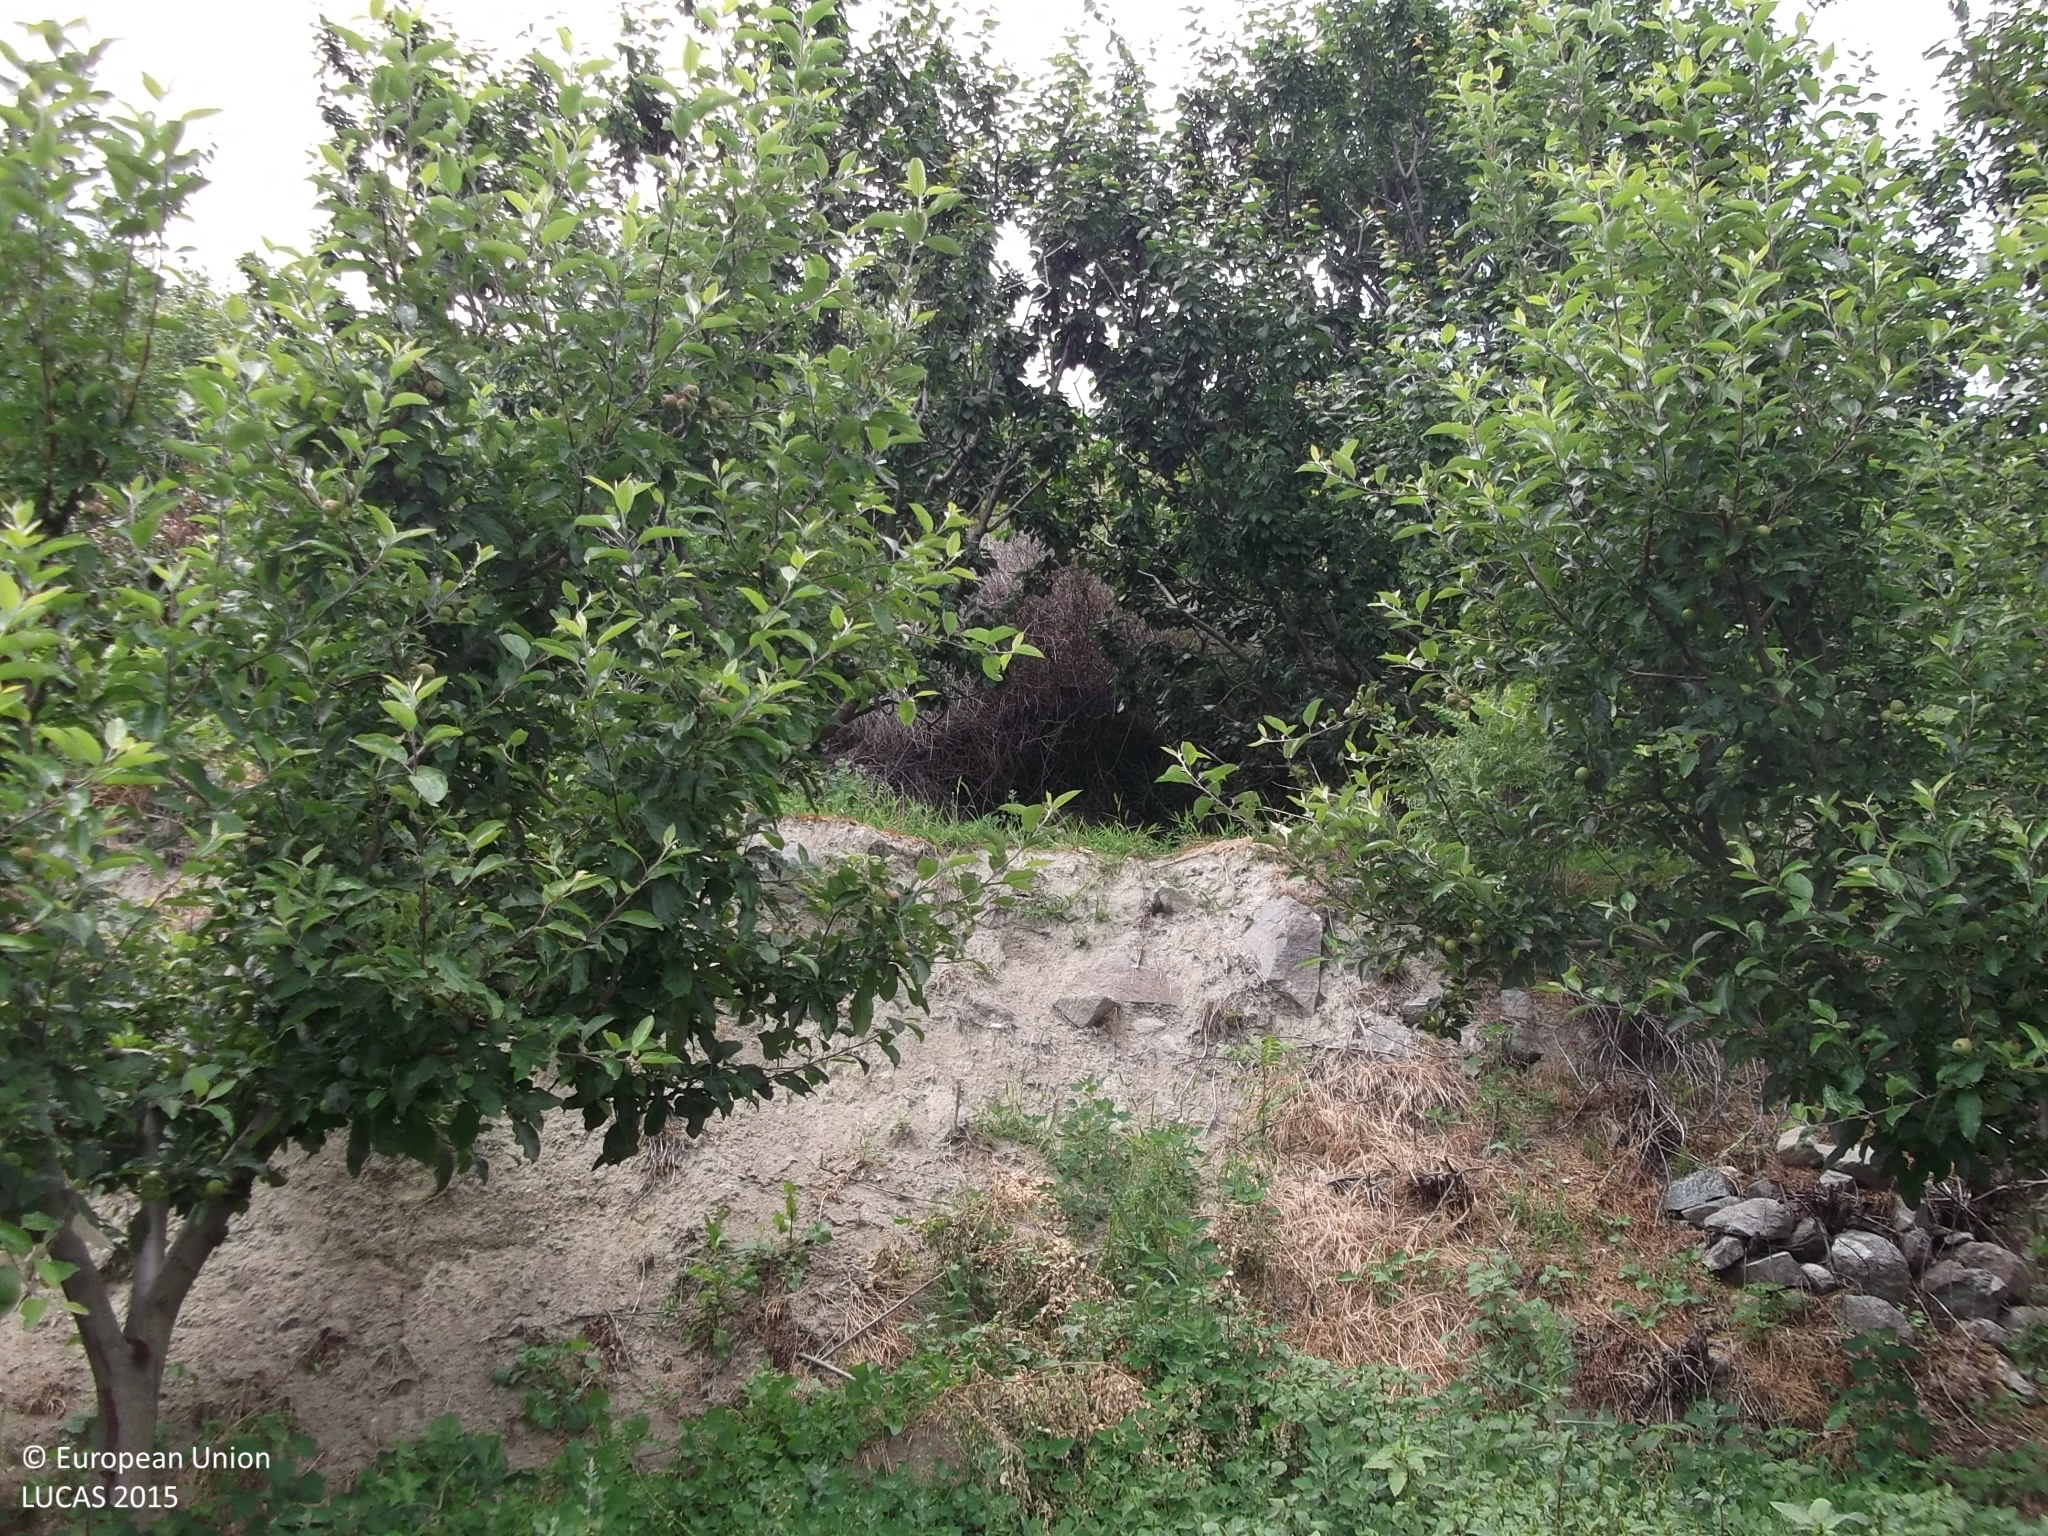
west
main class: Cropland
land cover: Apple fruit
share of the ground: 50 - 75 %
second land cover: Grassland without tree/shrub cover
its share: > 75 %
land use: Agriculture (excluding fallow land and kitchen gardens)
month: June
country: CY
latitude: 34.9144
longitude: 32.9690
